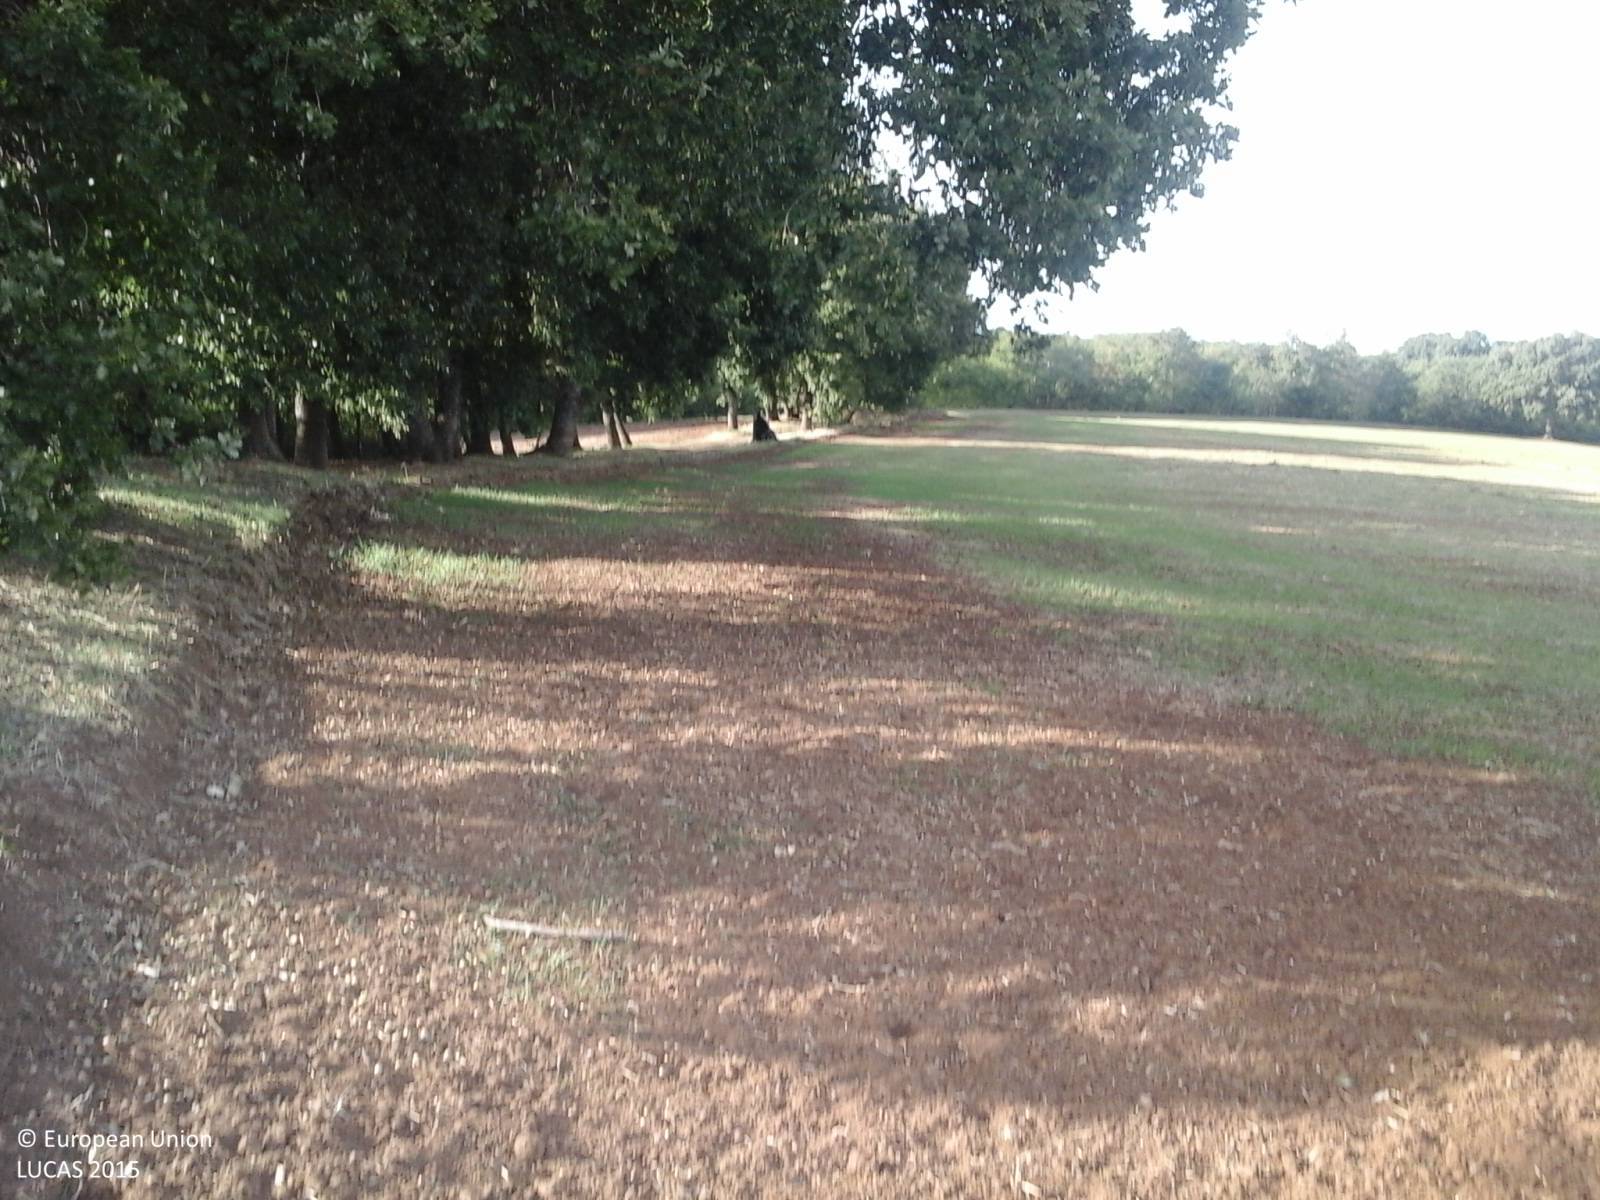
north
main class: Cropland
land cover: Oats
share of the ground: < 10 %
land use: Agriculture (excluding fallow land and kitchen gardens)
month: September
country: IT
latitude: 42.3910
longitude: 12.3850
